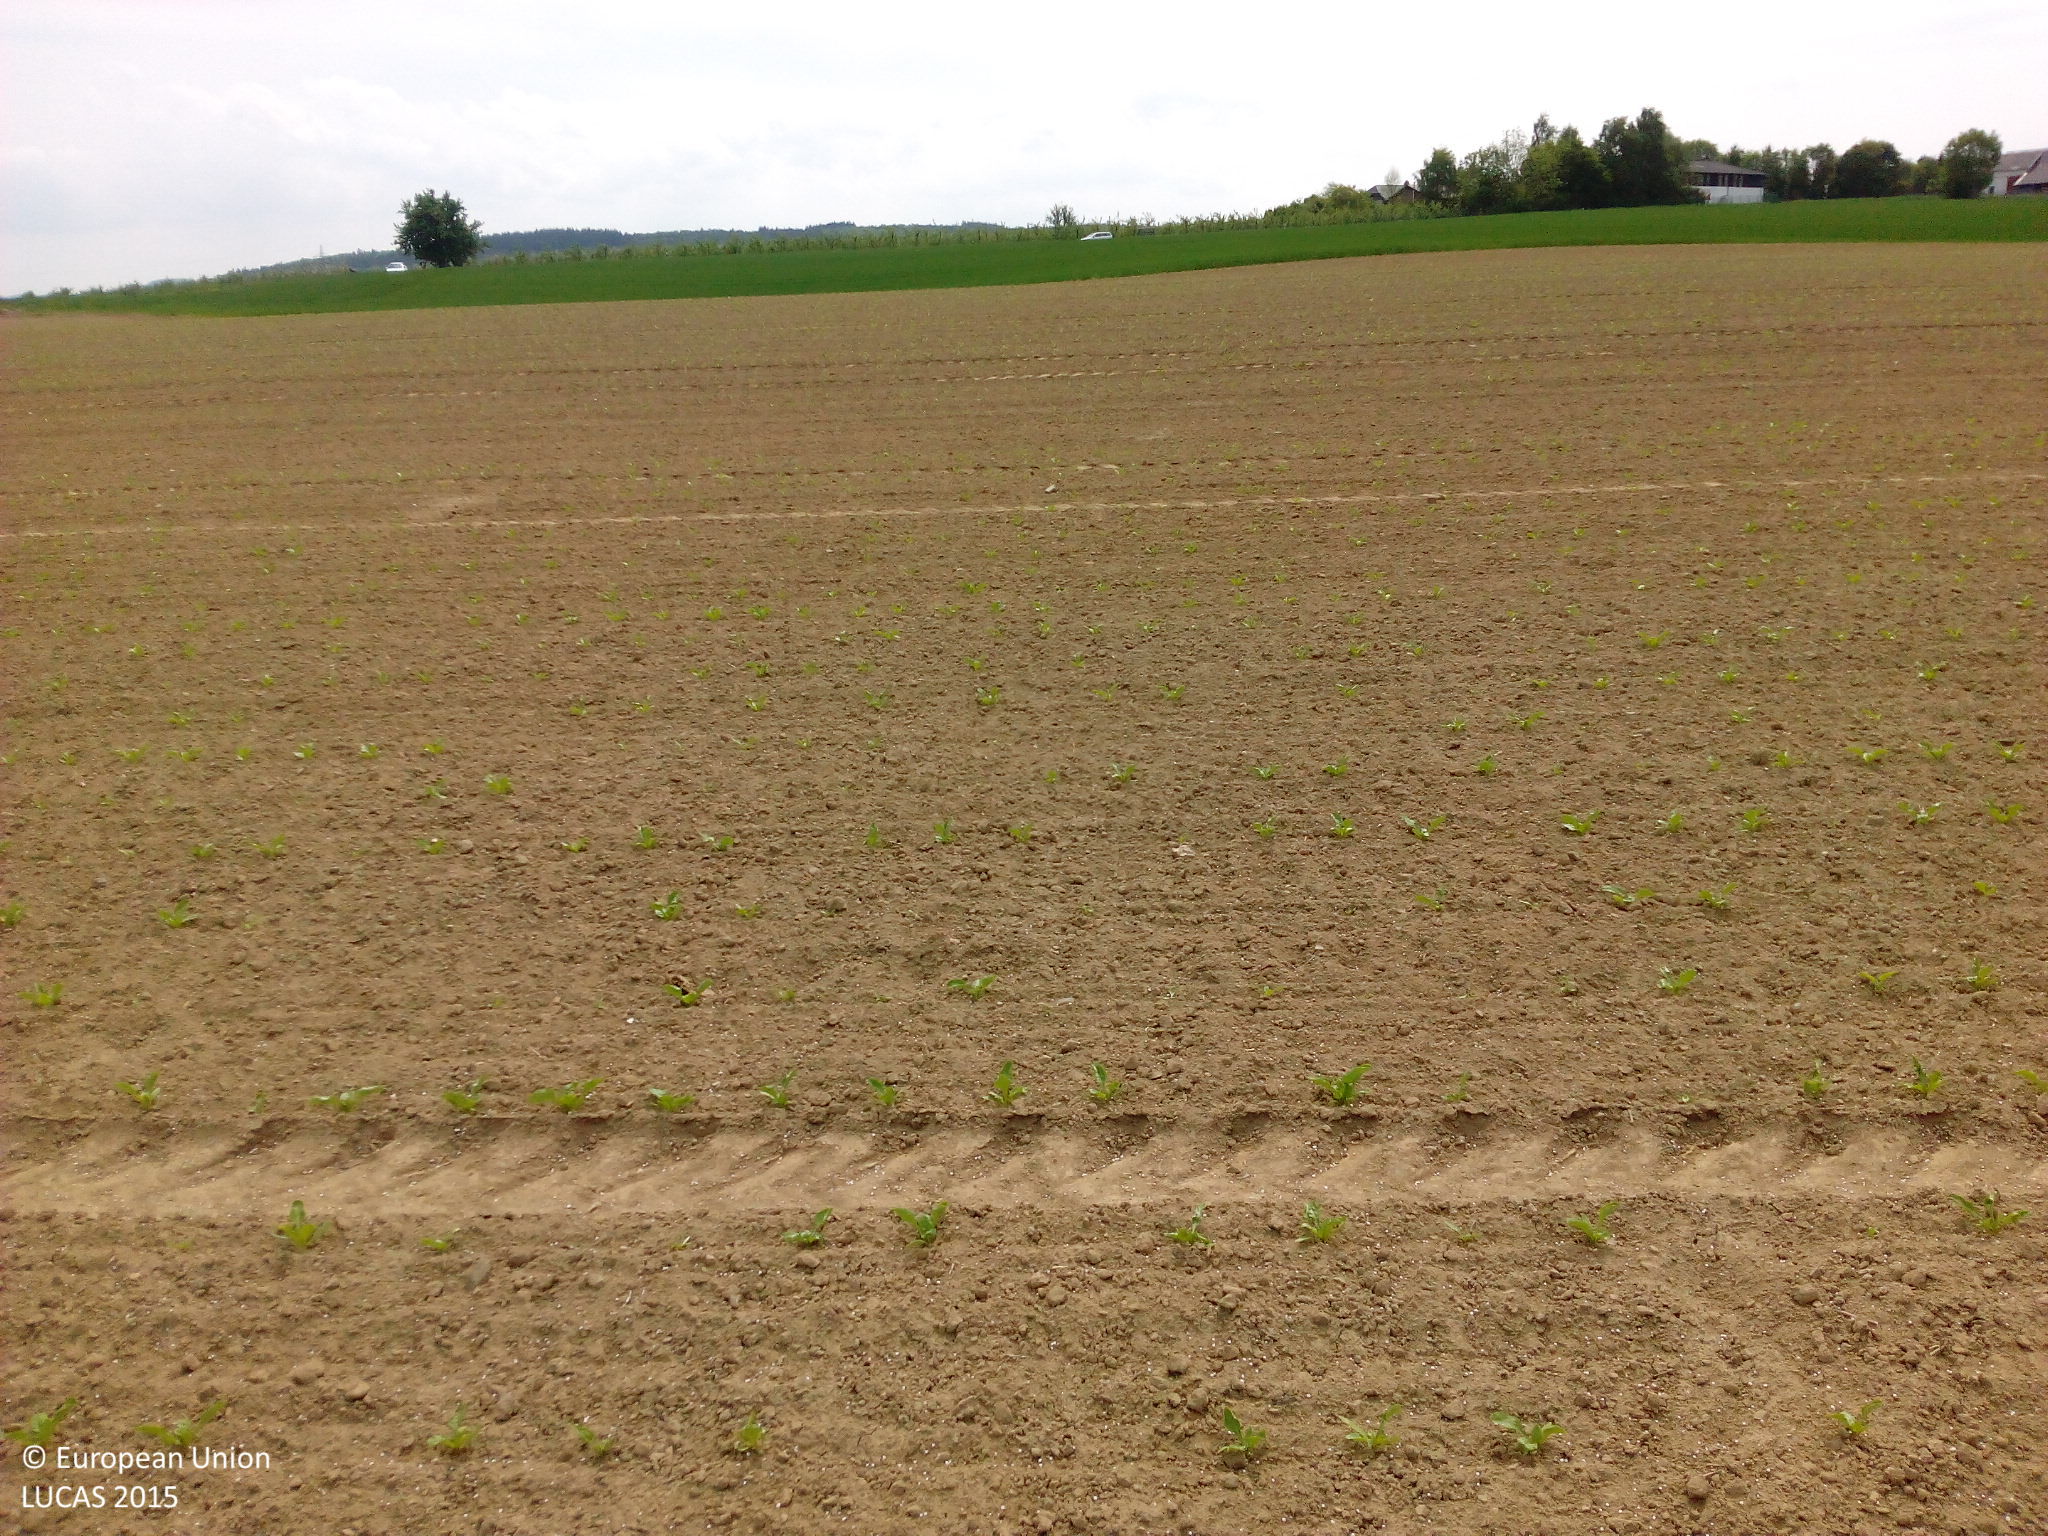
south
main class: Cropland
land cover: Sugar beet
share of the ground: < 10 %
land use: Agriculture (excluding fallow land and kitchen gardens)
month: May
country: DE
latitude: 50.5592
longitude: 7.0215
